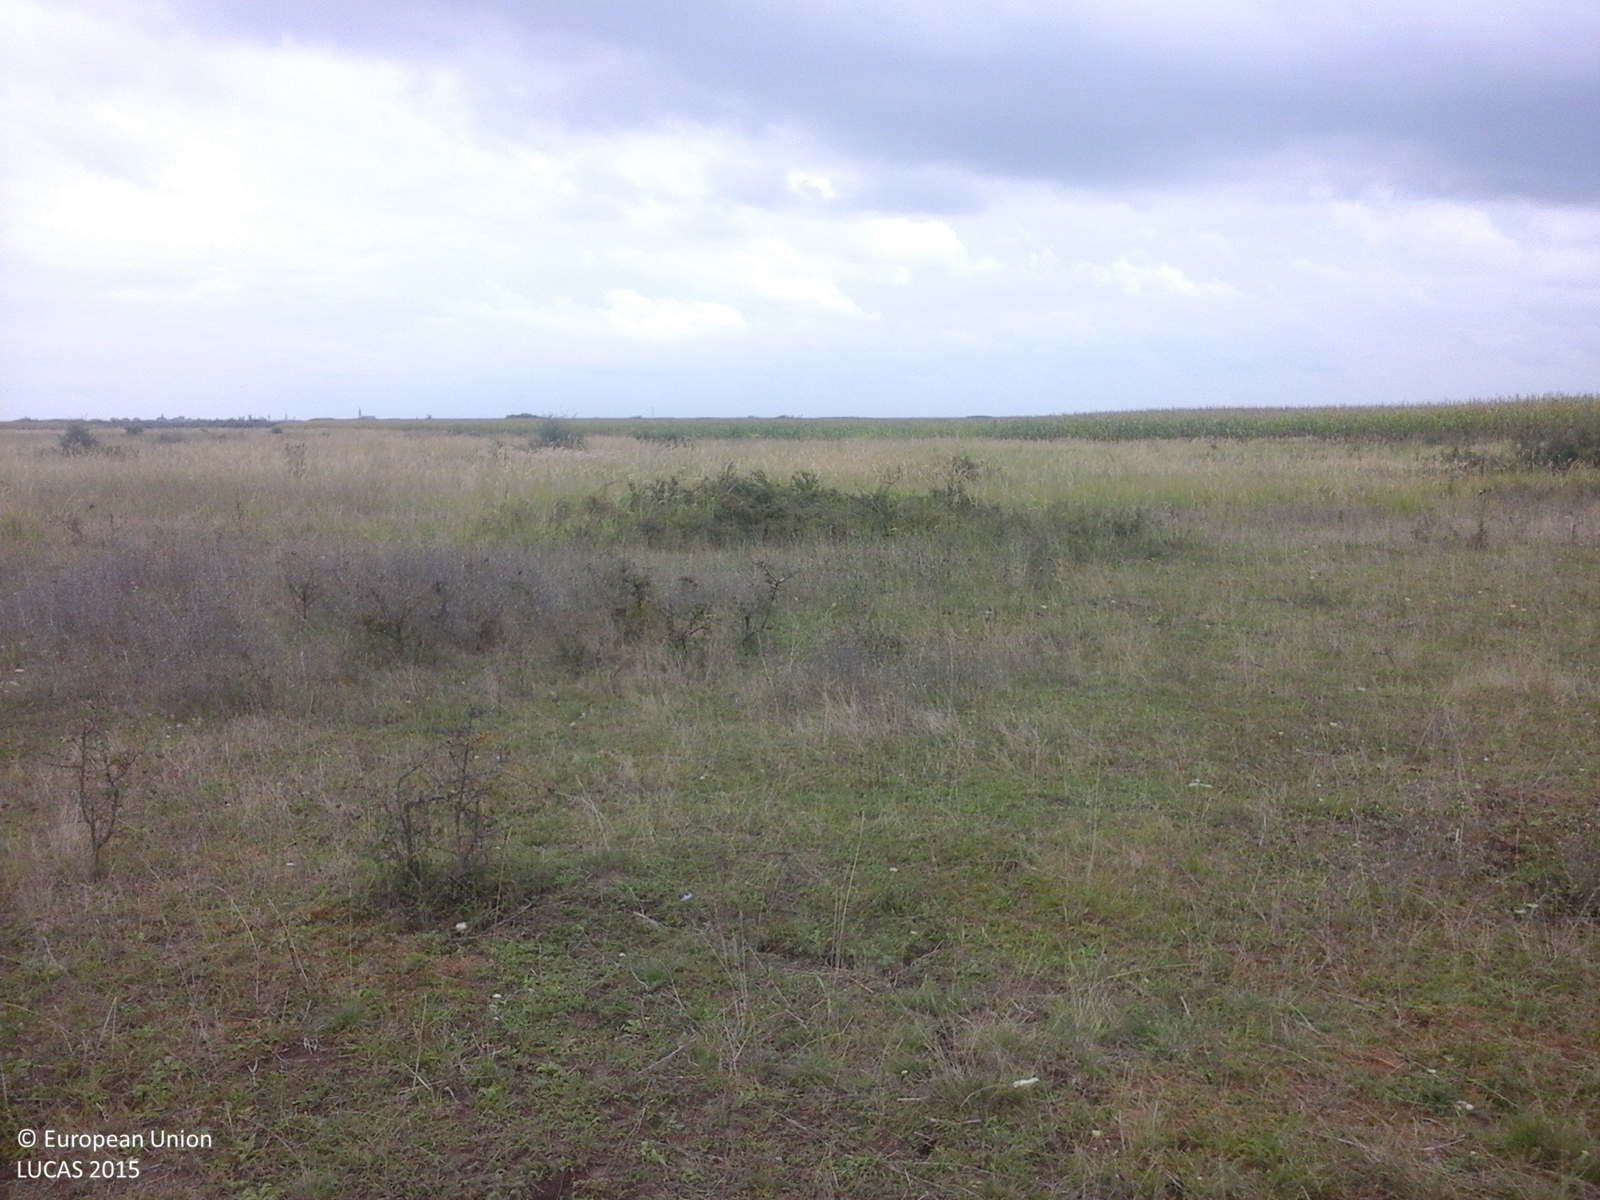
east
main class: Grassland
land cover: Grassland with sparse tree/shrub cover
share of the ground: > 75 %
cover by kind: herbaceous plants 85 %, shrubs 10 %, broadleaved forest trees 5 %
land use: Agriculture (excluding fallow land and kitchen gardens)
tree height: < 5 m
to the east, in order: Grassland with sparse tree/shrub cover; Shruby margins; Maize
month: August
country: RO
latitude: 45.5019
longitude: 21.0722
